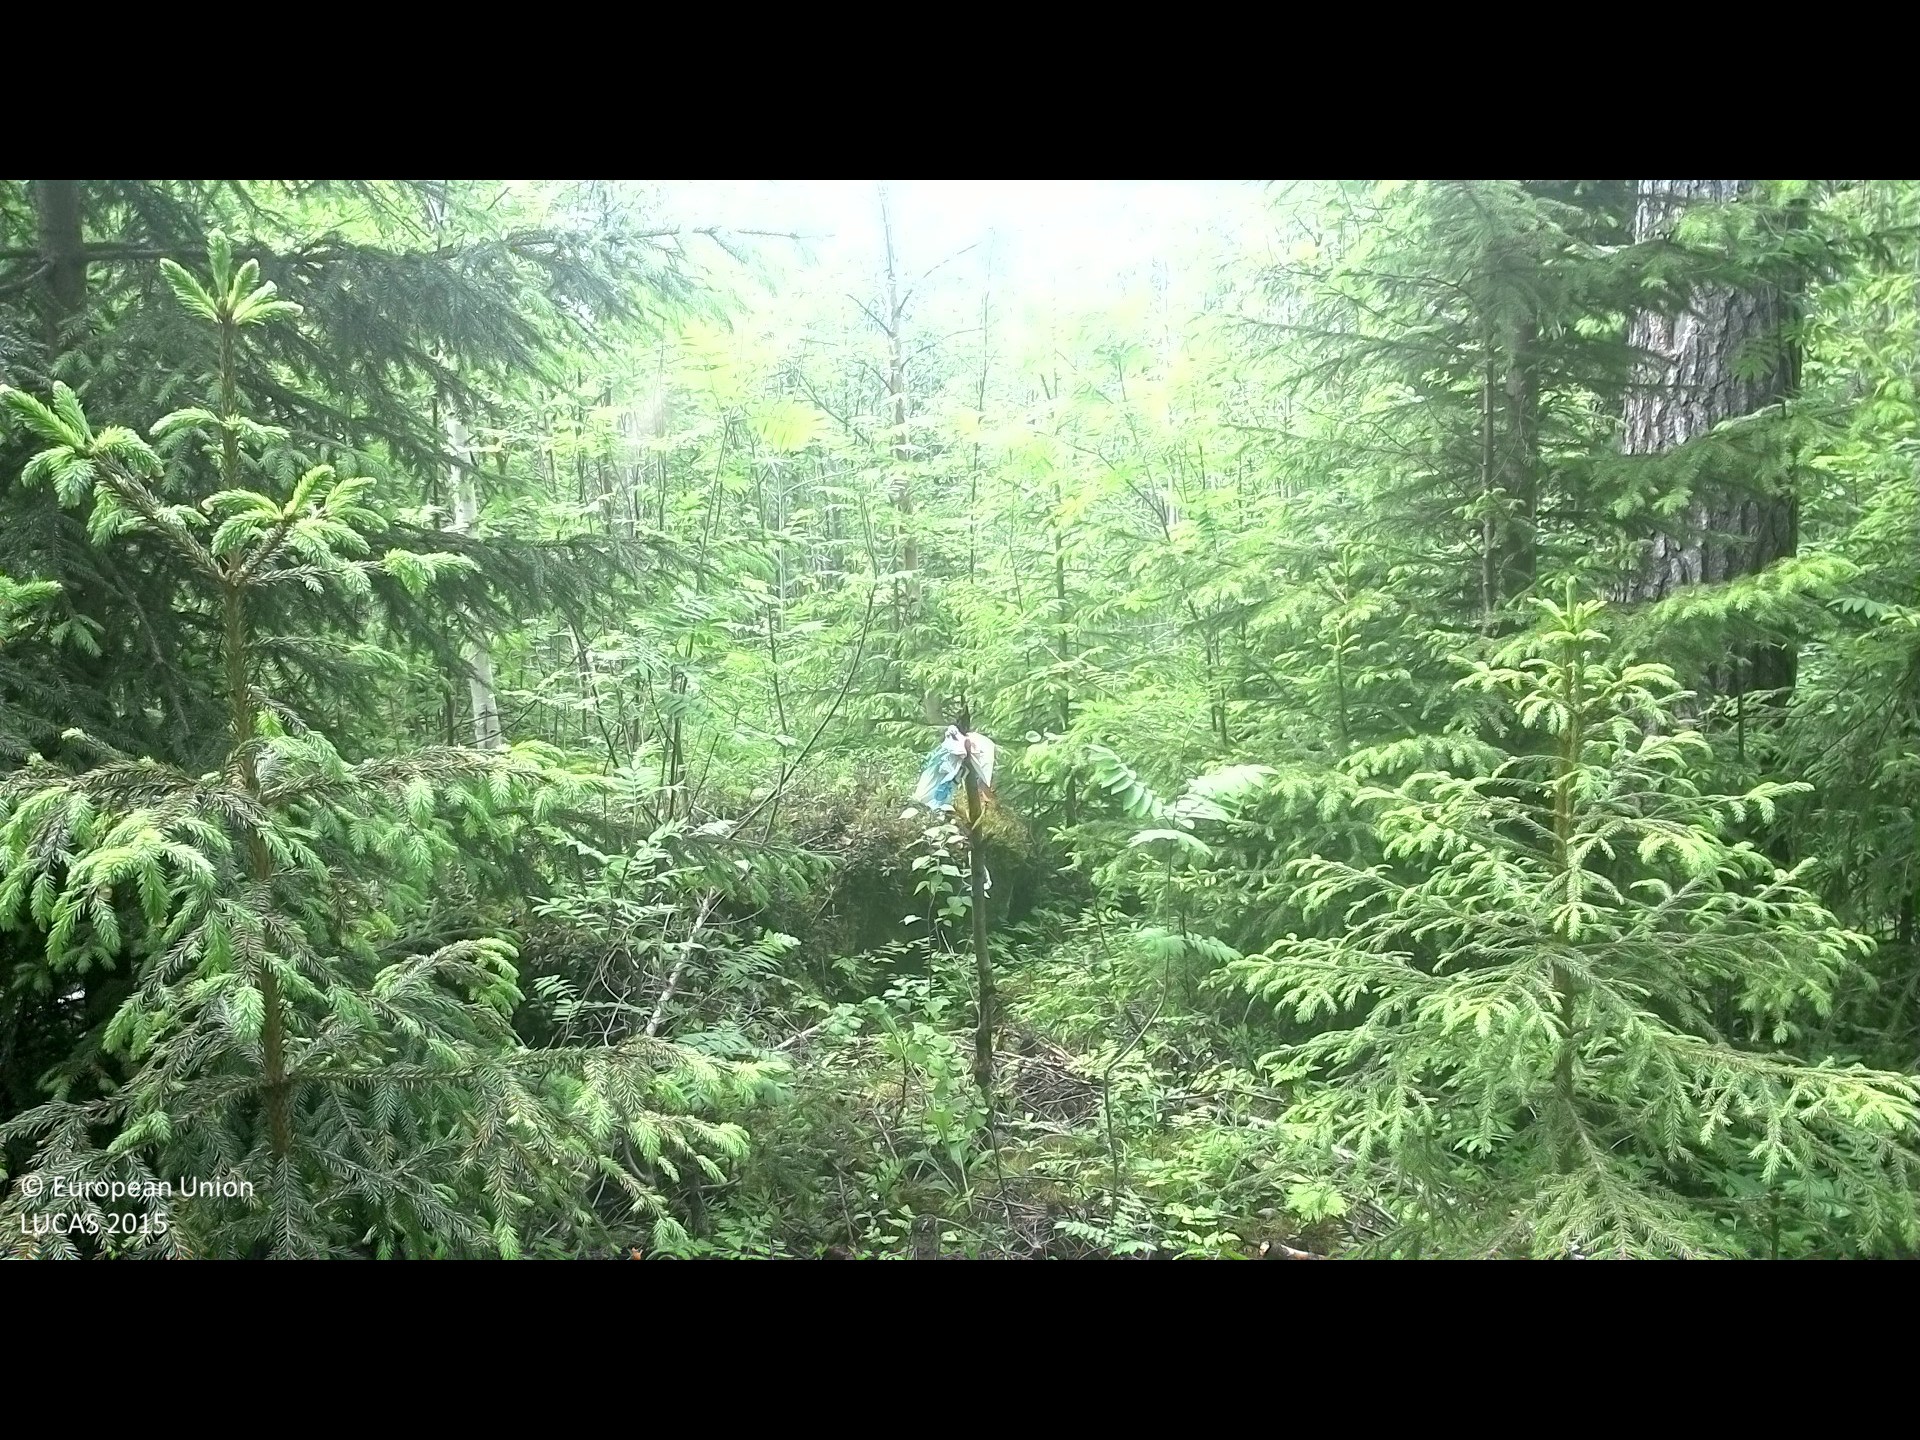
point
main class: Woodland
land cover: Other mixed woodland
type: boreal forest
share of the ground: 50 - 75 %
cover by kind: broadleaved forest trees 35 %, coniferous forest trees 30 %, herbaceous plants 20 %, lichens and mosses 15 %
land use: Forestry
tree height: > 5 m
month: June
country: SE
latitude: 62.0813
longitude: 16.7396
